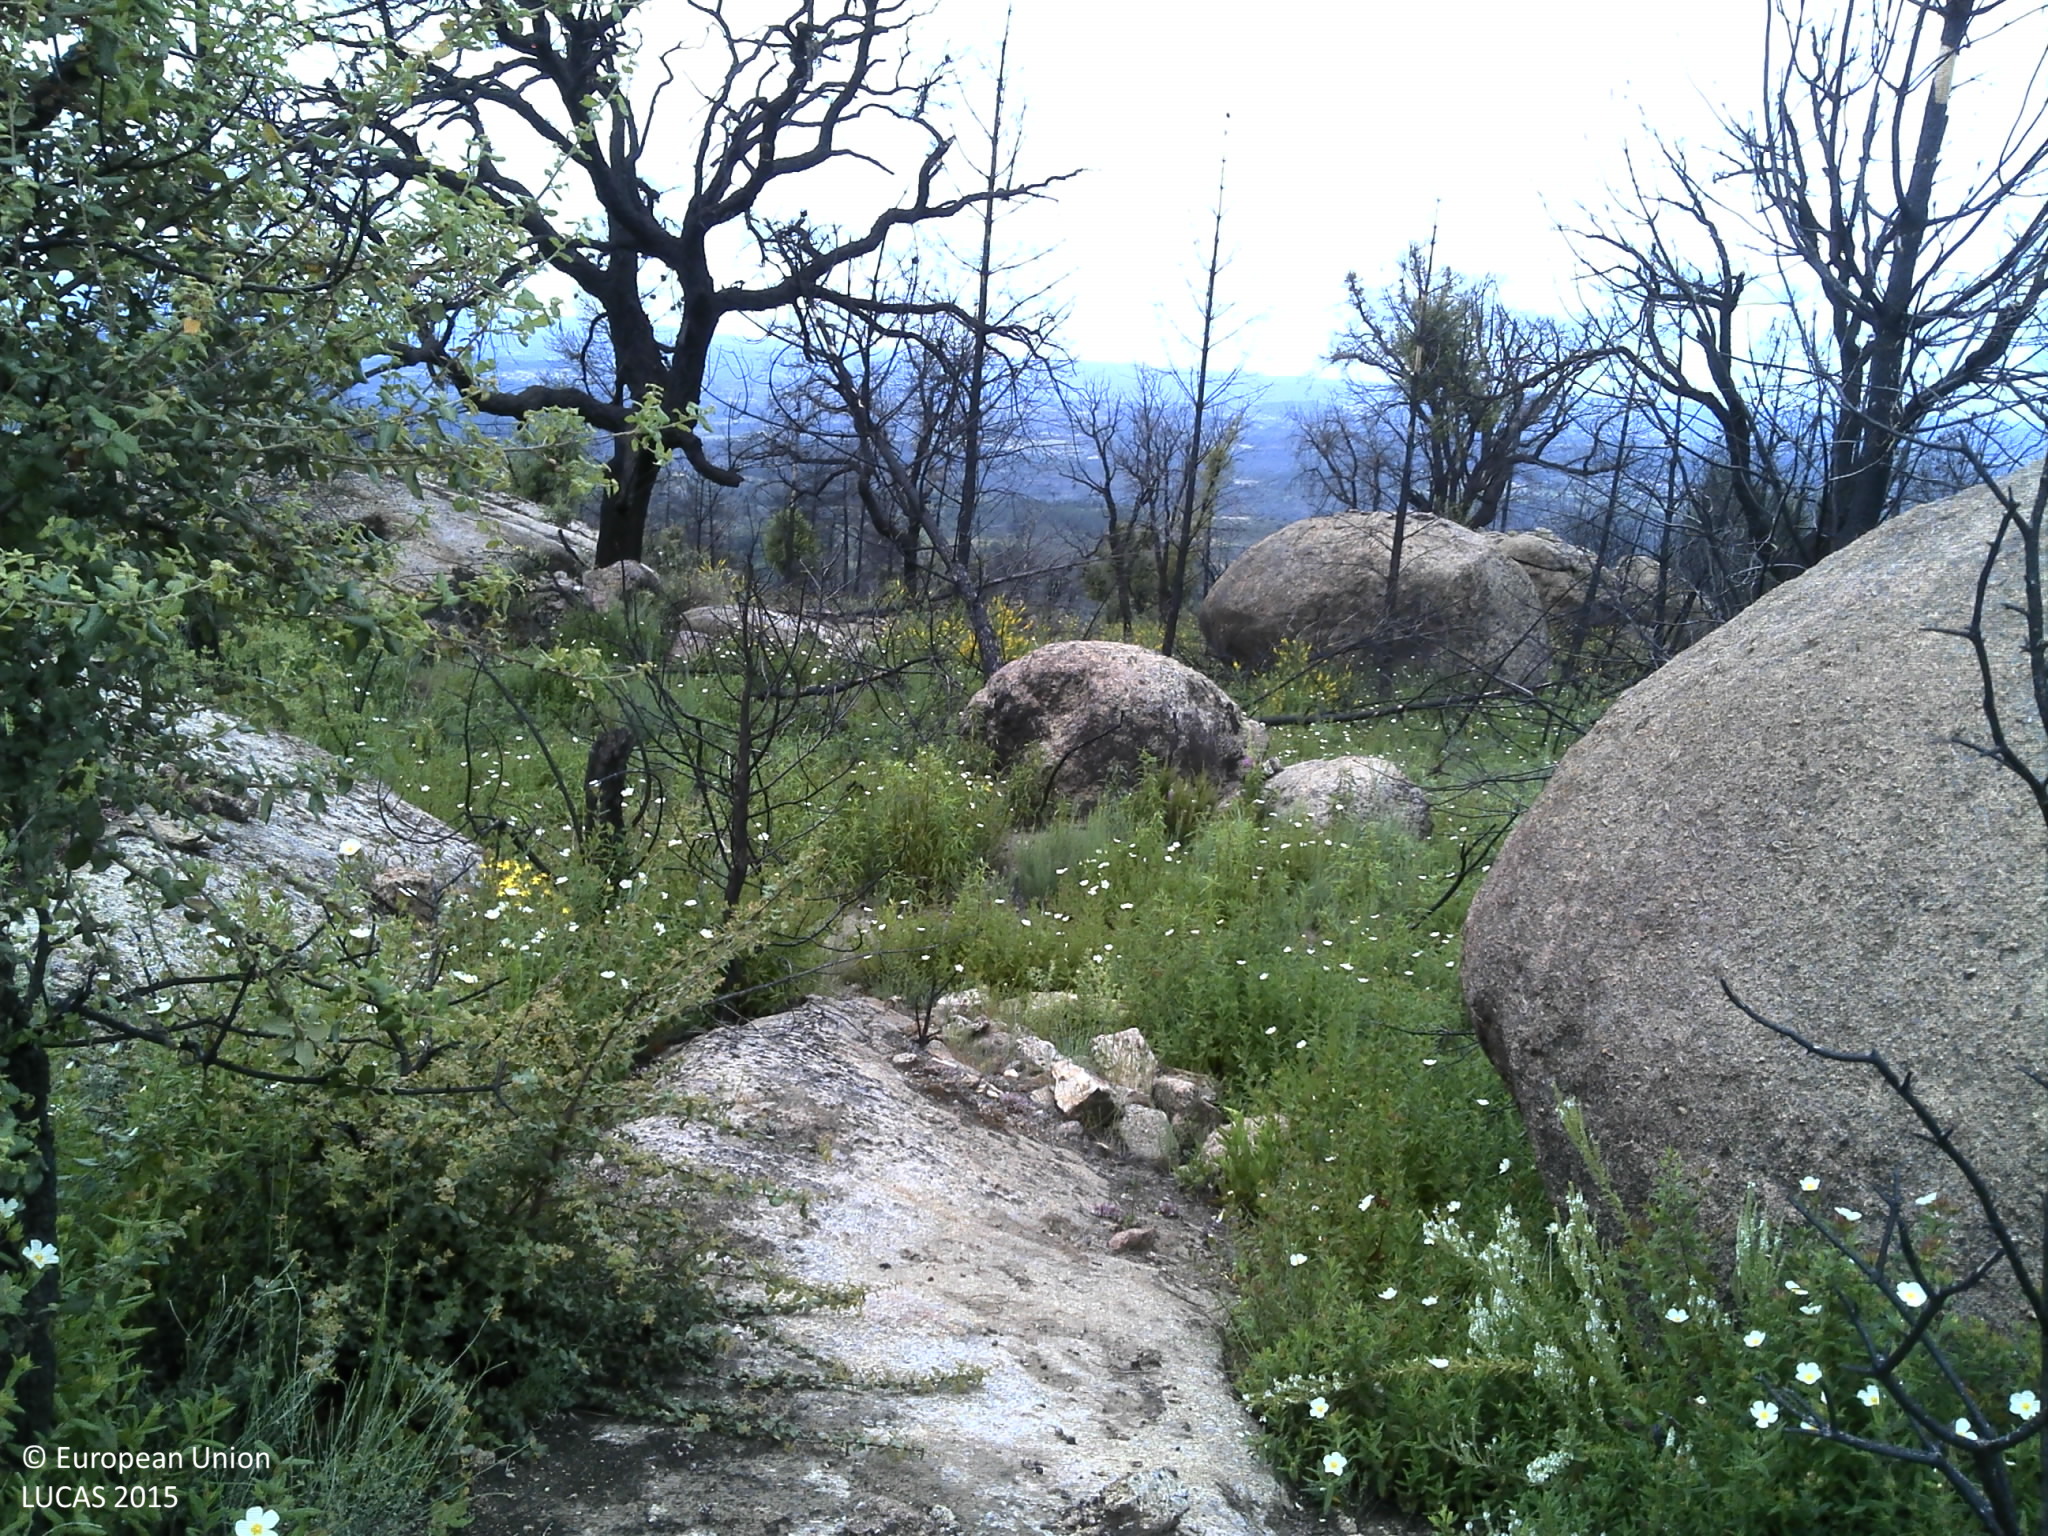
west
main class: Shrubland
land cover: Shrubland with sparse tree cover
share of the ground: 50 - 75 %
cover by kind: shrubs 50 %, consolidated bare surface 45 %, broadleaved forest trees 5 %
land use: Forestry
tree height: < 5 m
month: May
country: PT
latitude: 41.6677
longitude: -7.0902
